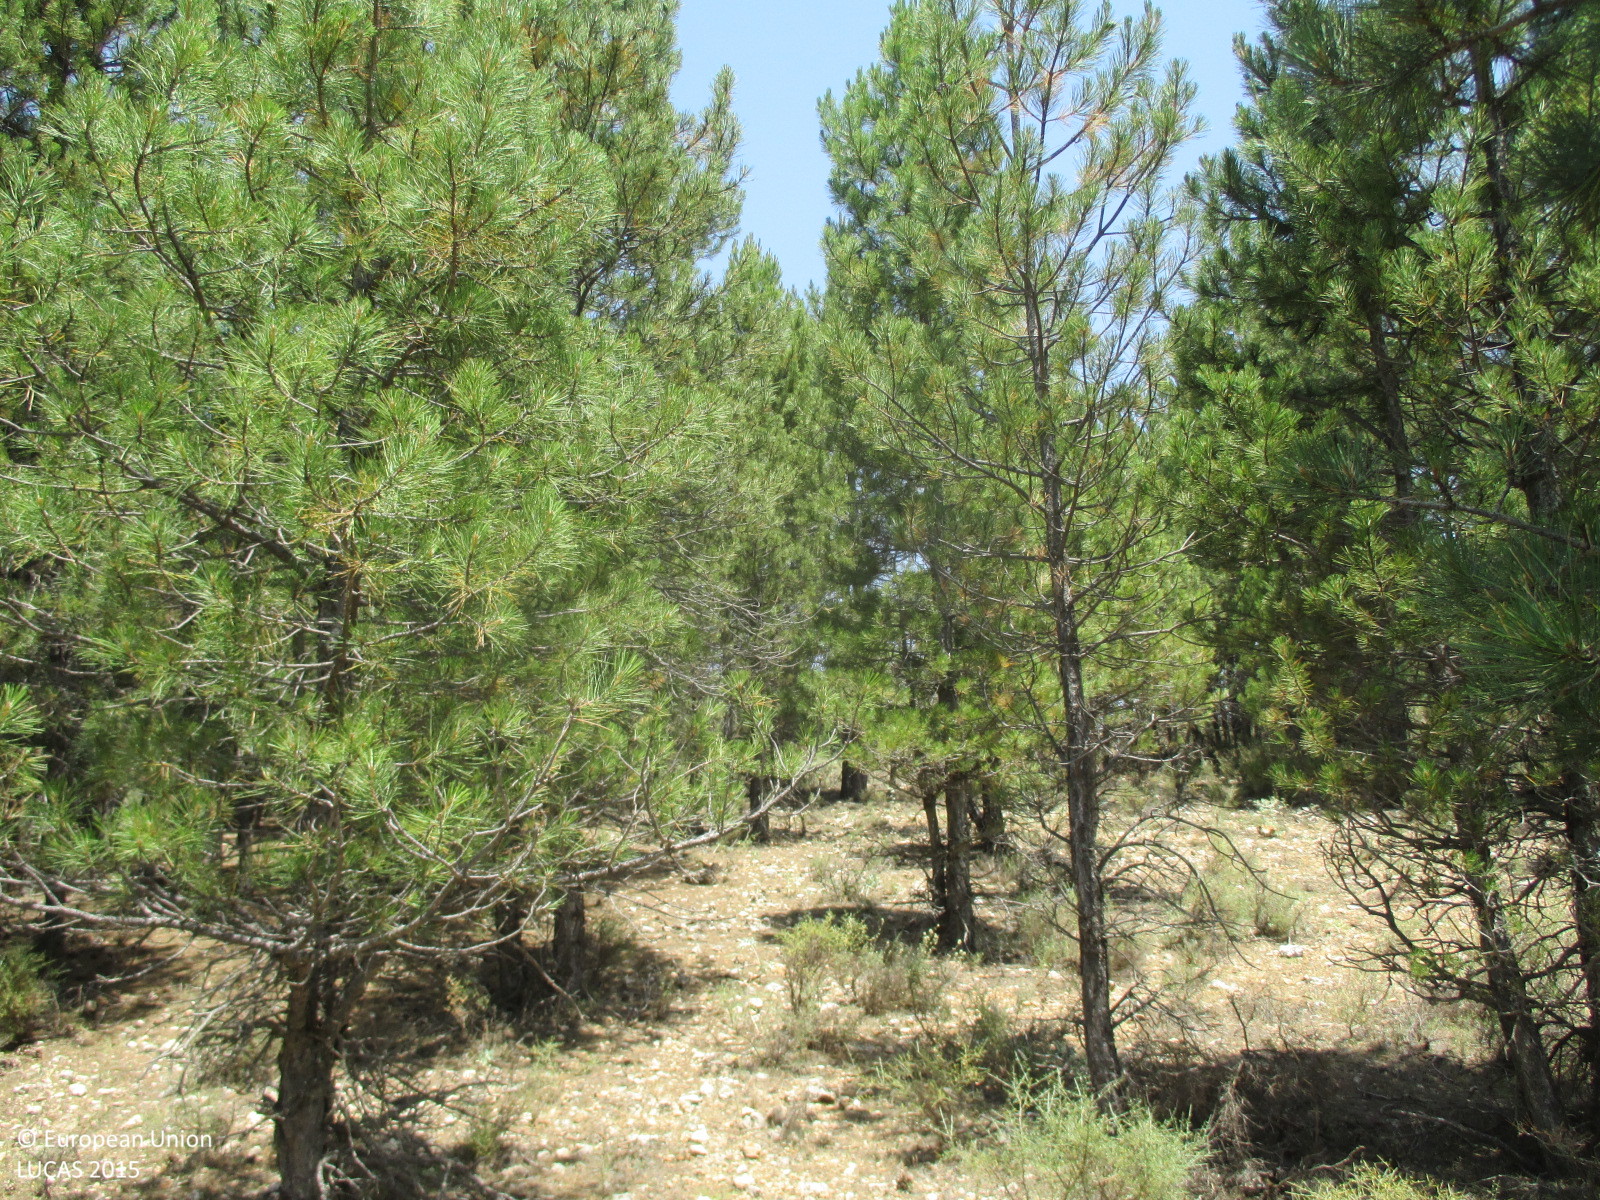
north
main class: Woodland
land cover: Pine dominated coniferous woodland
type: coniferous forest of the mediterranean region
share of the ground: > 75 %
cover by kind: coniferous forest trees 75 %, herbaceous plants 20 %, shrubs 5 %
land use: Forestry
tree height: > 5 m
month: July
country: ES
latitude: 38.0738
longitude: -2.4984
